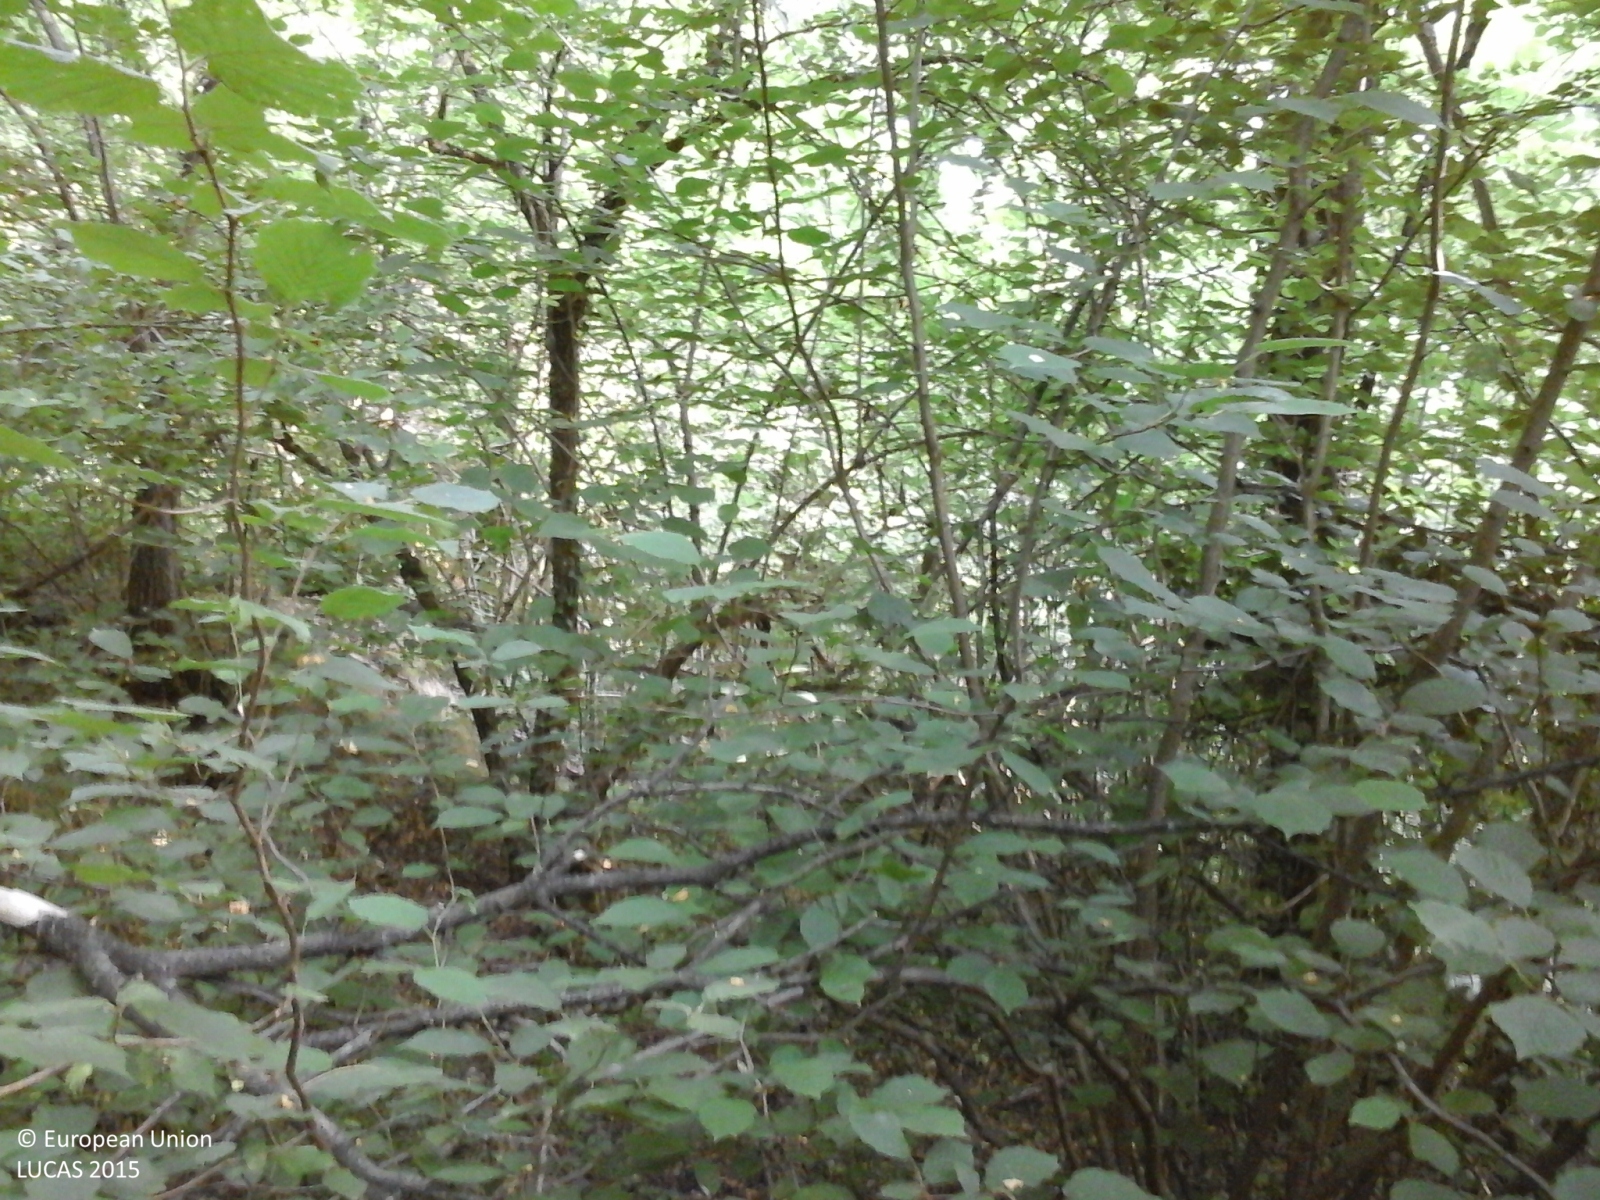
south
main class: Woodland
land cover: Broadleaved woodland
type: thermophilous deciduous forest
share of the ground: > 75 %
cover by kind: broadleaved forest trees 100 %
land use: Semi-natural and natural areas not in use
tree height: > 5 m
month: June
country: IT
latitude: 44.6855
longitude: 8.7283
